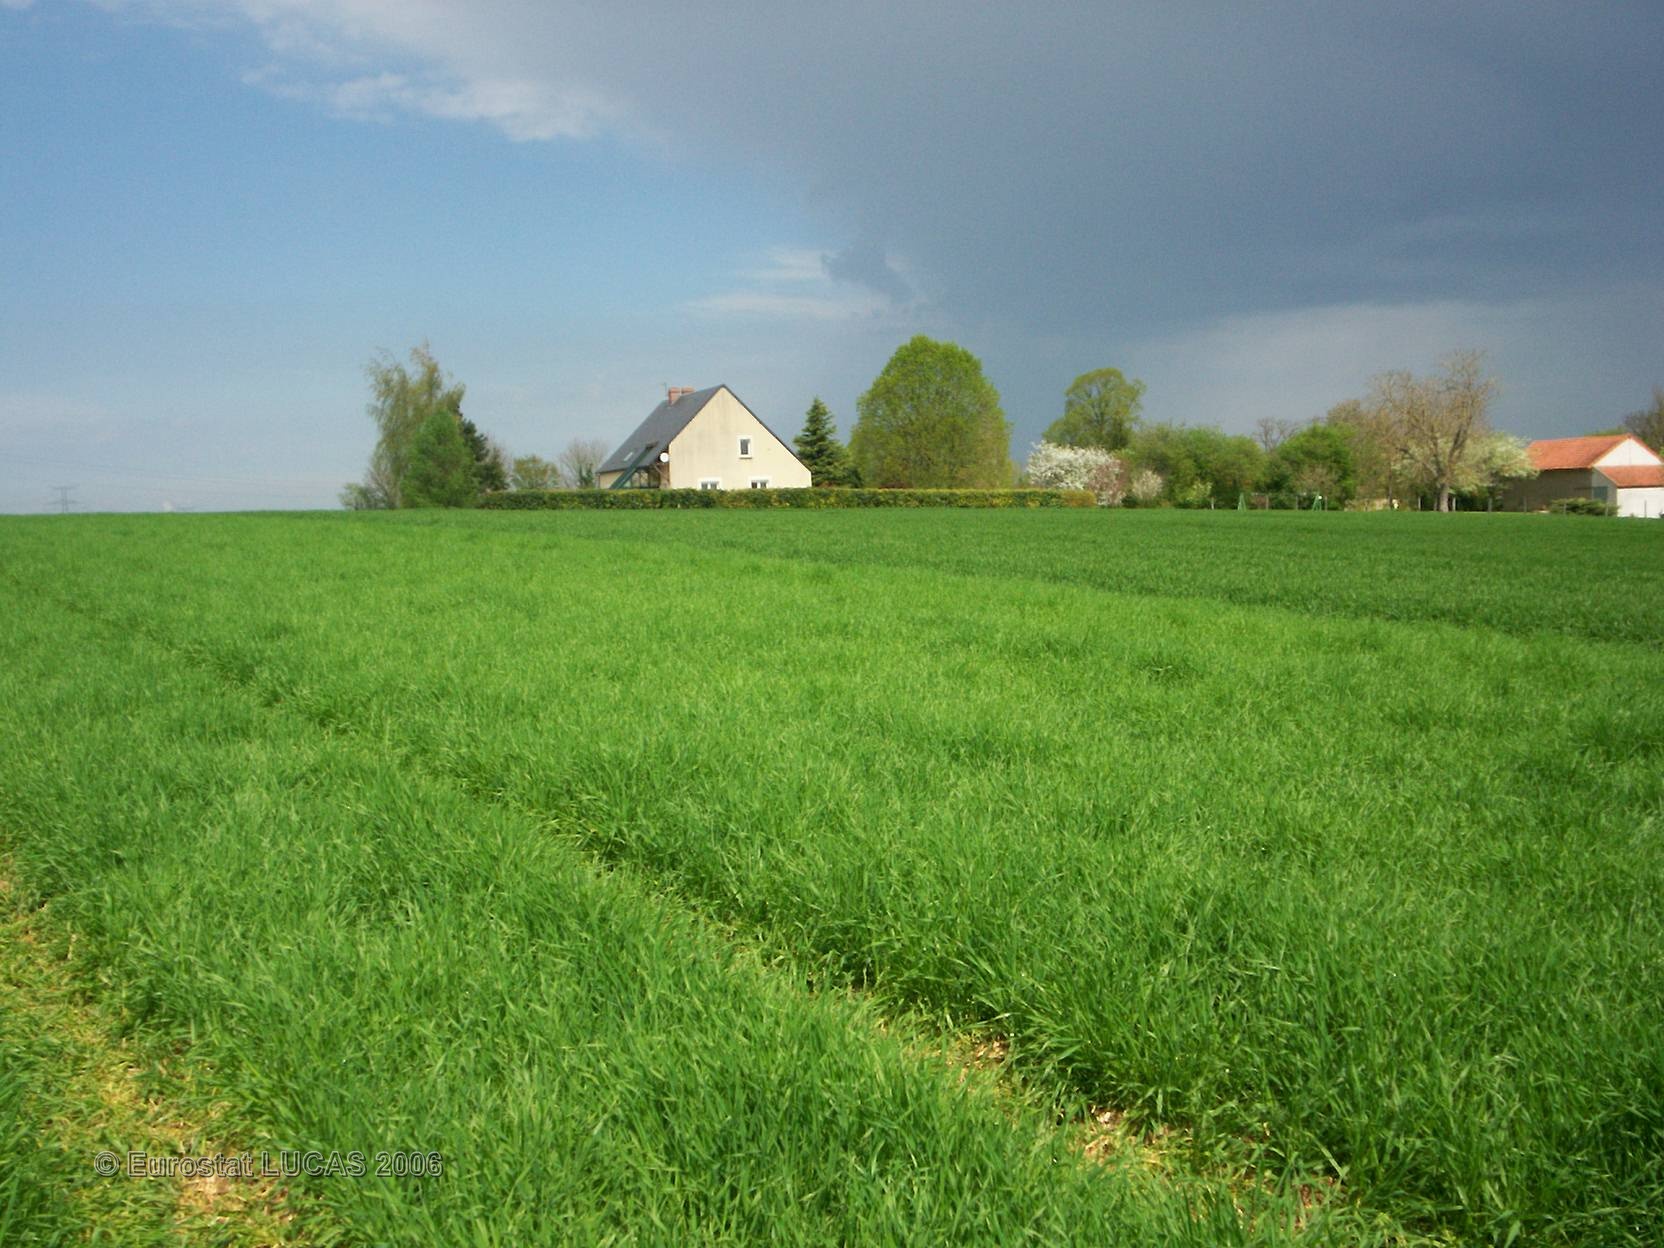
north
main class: Cropland
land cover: Barley
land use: Agriculture (excluding fallow land and kitchen gardens)
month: April
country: FR
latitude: 47.3339
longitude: 3.0207
